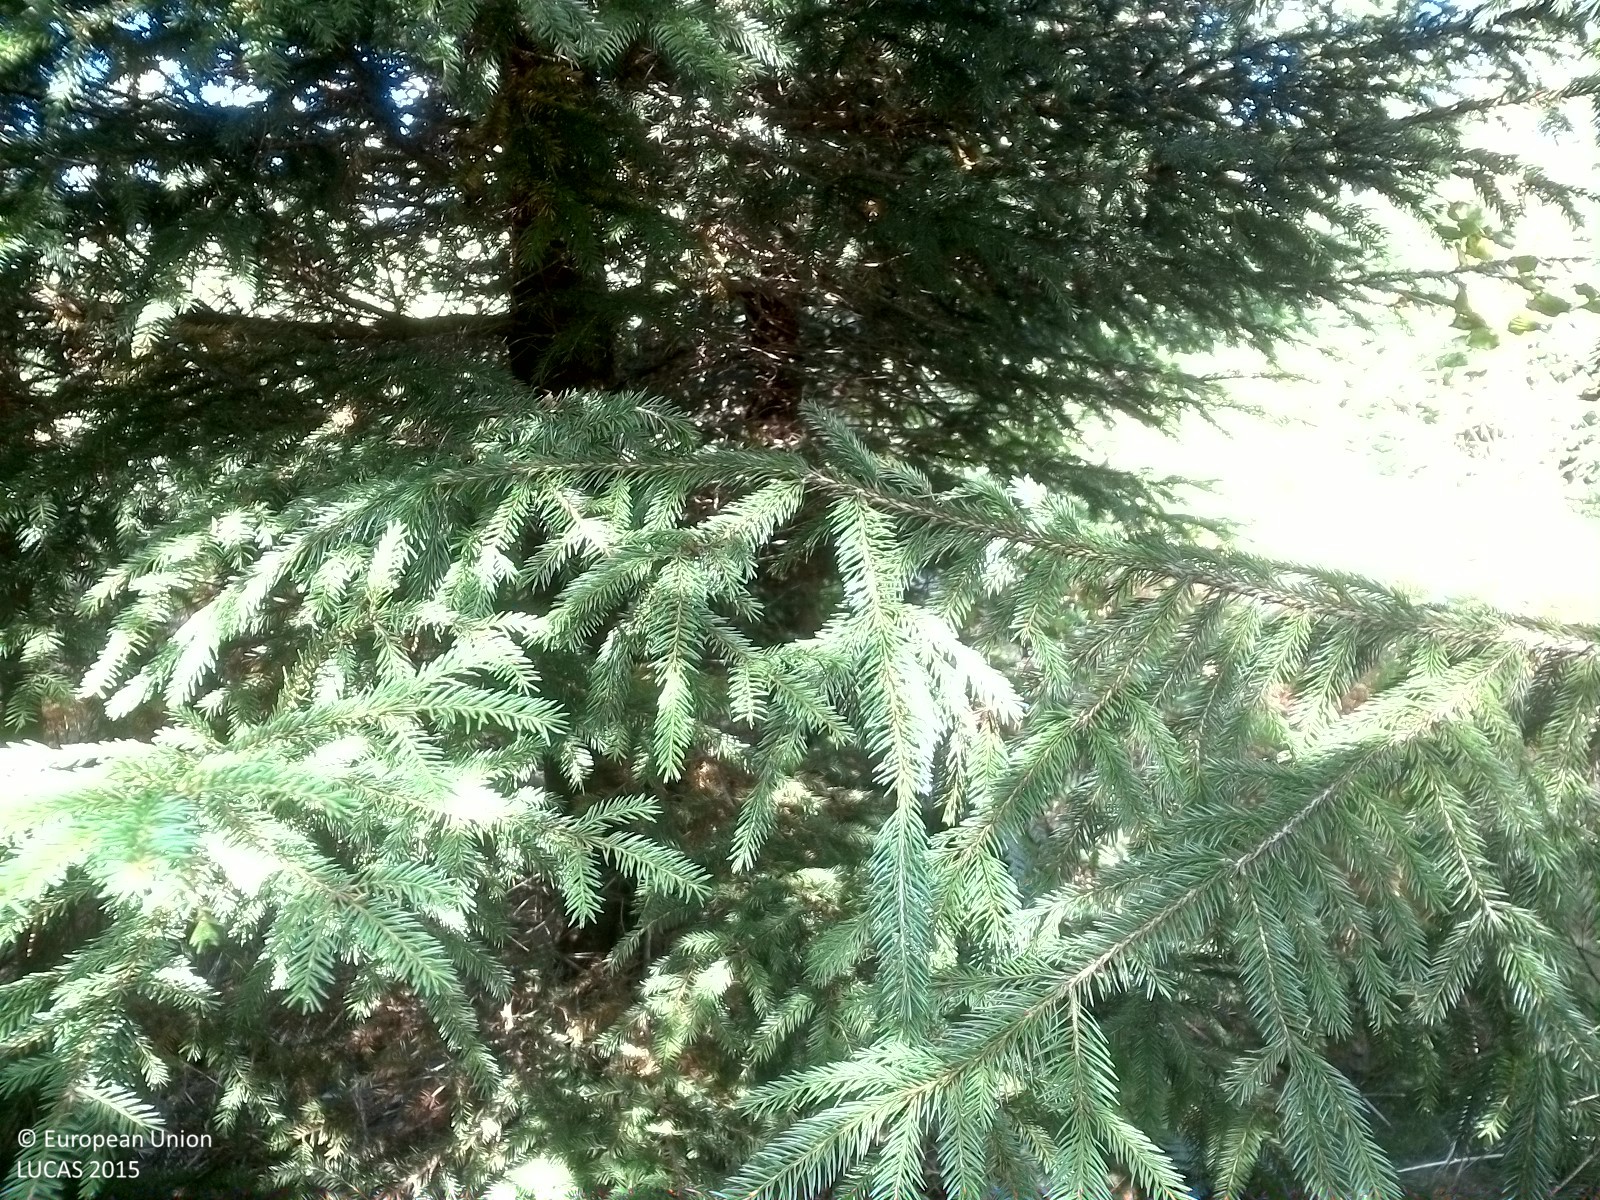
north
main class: Woodland
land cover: Spruce dominated mixed woodland
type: boreal forest
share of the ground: 50 - 75 %
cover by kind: coniferous forest trees 40 %, broadleaved forest trees 30 %, herbaceous plants 20 %, lichens and mosses 10 %
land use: Forestry
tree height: < 5 m
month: August
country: SE
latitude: 58.6132
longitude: 15.0029
